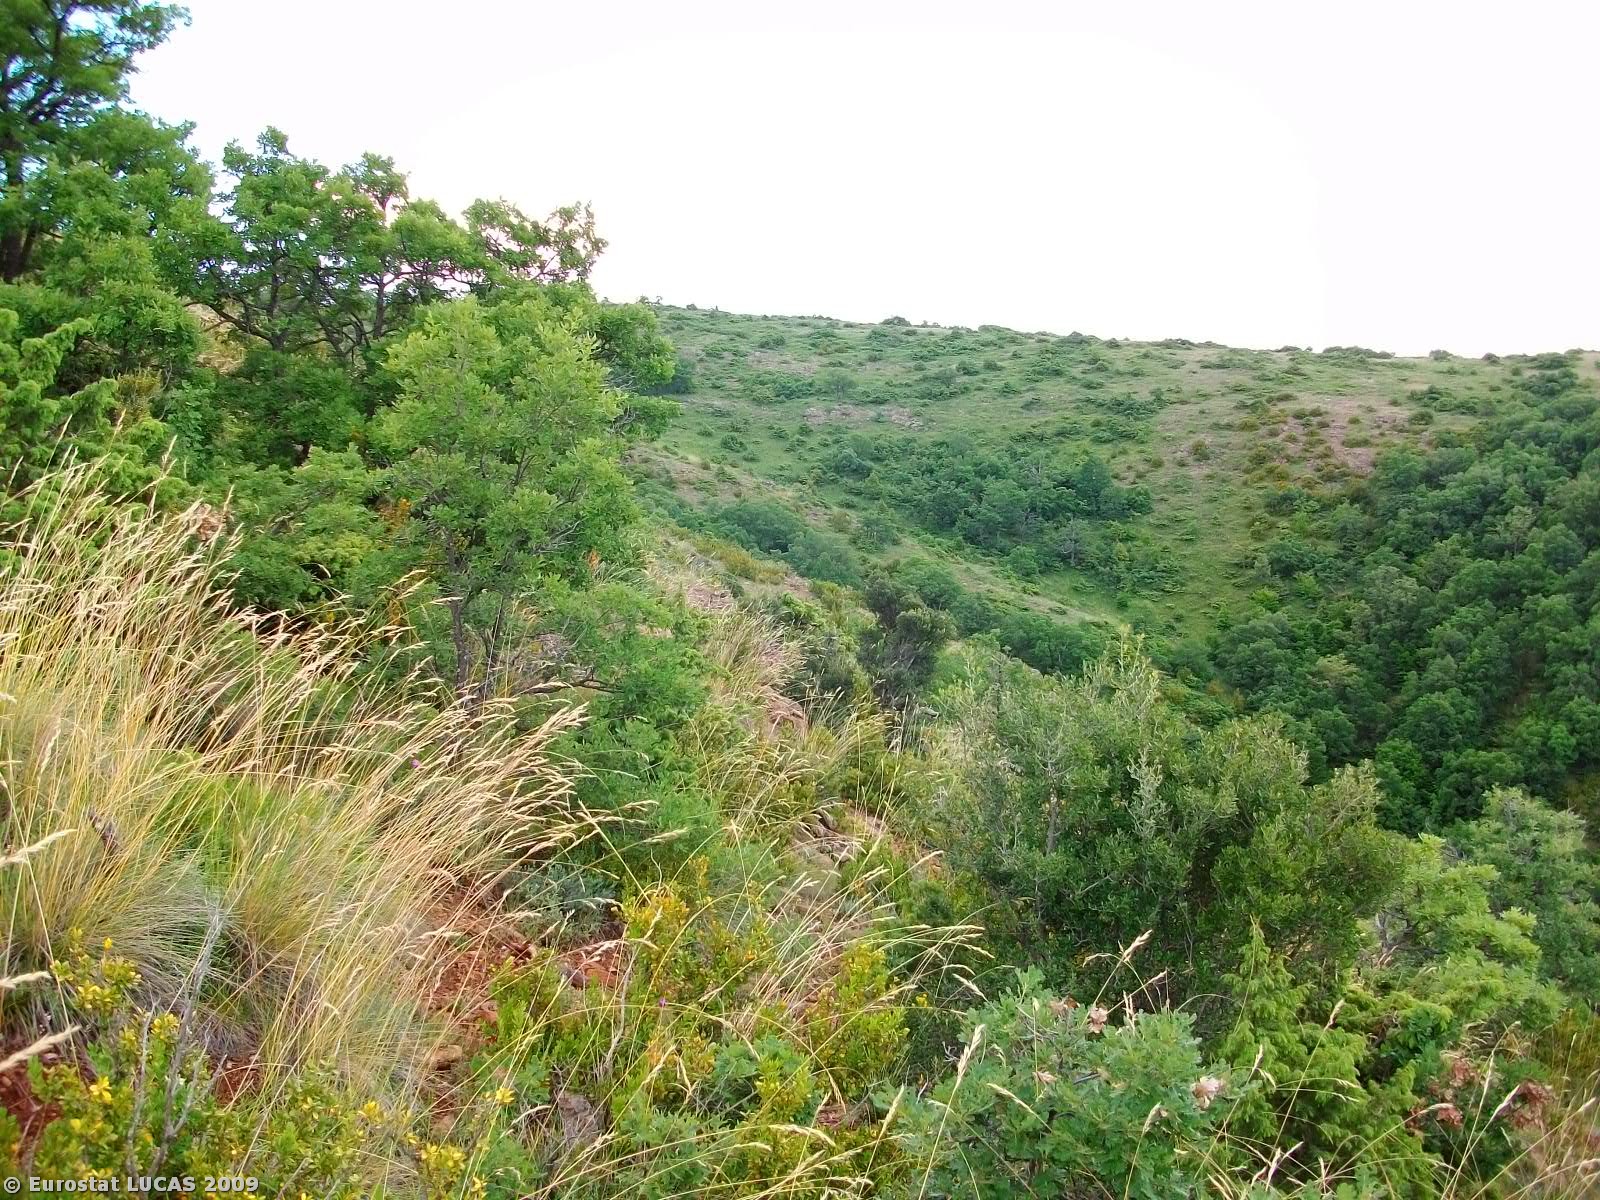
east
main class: Shrubland
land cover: Shrubland with sparse tree cover
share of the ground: > 75 %
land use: Unused
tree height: > 5 m
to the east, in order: Shrubland with sparse tree cover; Rock outcrops; Shrubland with sparse tree cover; Rock outcrops; Shrubland with sparse tree cover; Broadleaved woodland; Shrubland with sparse tree cover; Rock outcrops; Broadleaved woodland
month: June
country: GR
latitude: 40.0344
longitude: 21.7429
